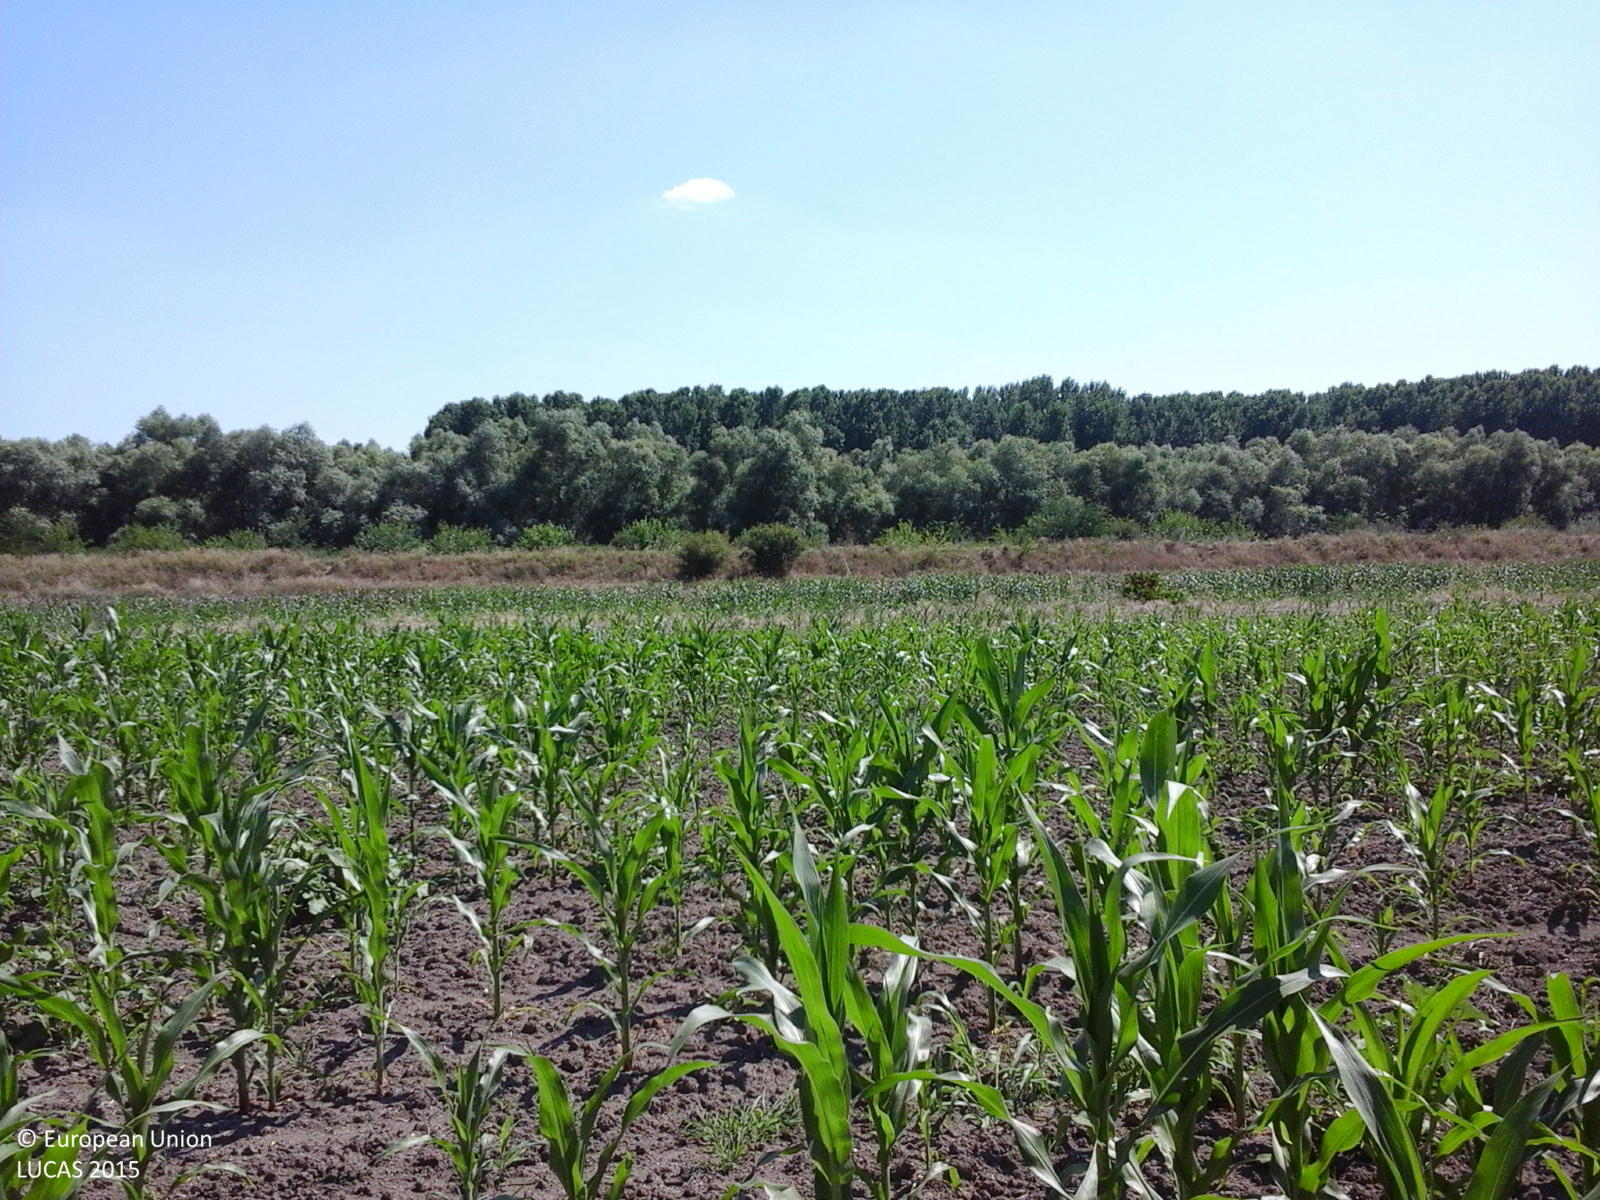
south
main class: Cropland
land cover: Maize
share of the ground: 50 - 75 %
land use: Agriculture (excluding fallow land and kitchen gardens)
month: July
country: RO
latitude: 44.2139
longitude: 27.7055
